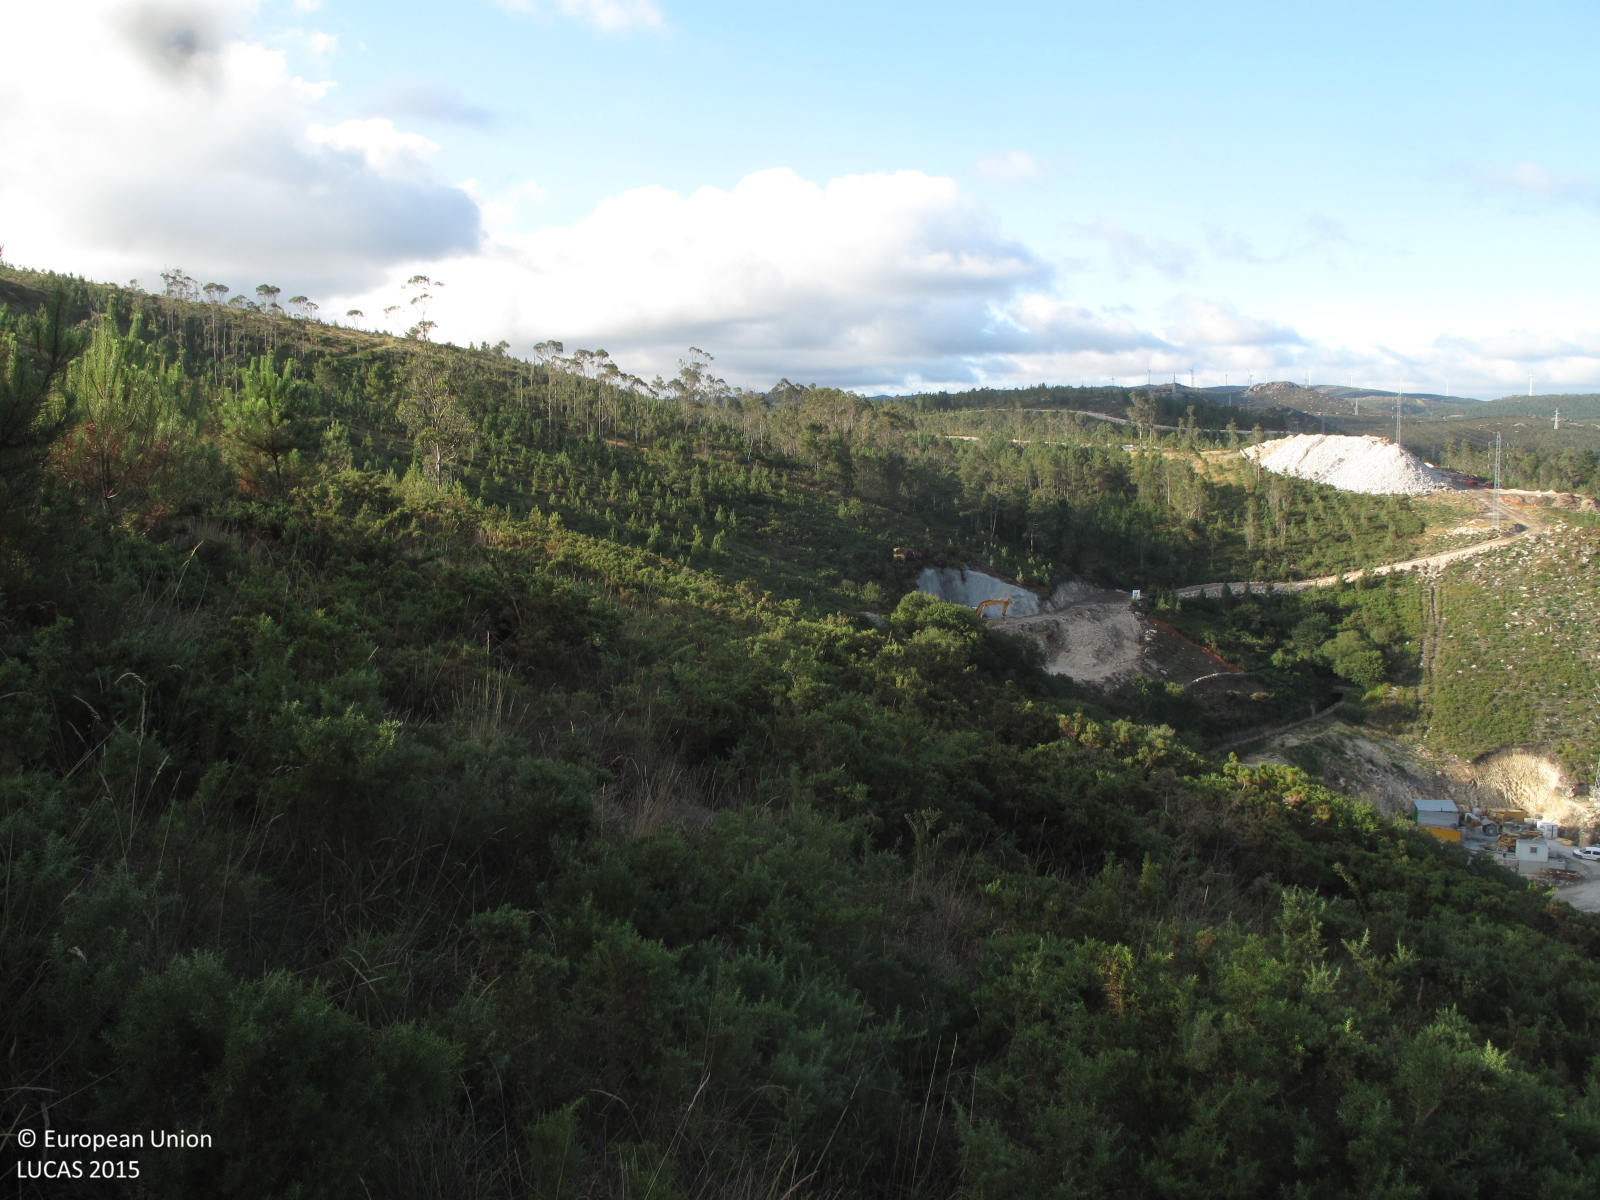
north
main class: Shrubland
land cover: Shrubland without tree cover
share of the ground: > 75 %
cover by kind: shrubs 90 %, herbaceous plants 10 %
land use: Semi-natural and natural areas not in use
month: July
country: ES
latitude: 42.9474
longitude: -9.0837
